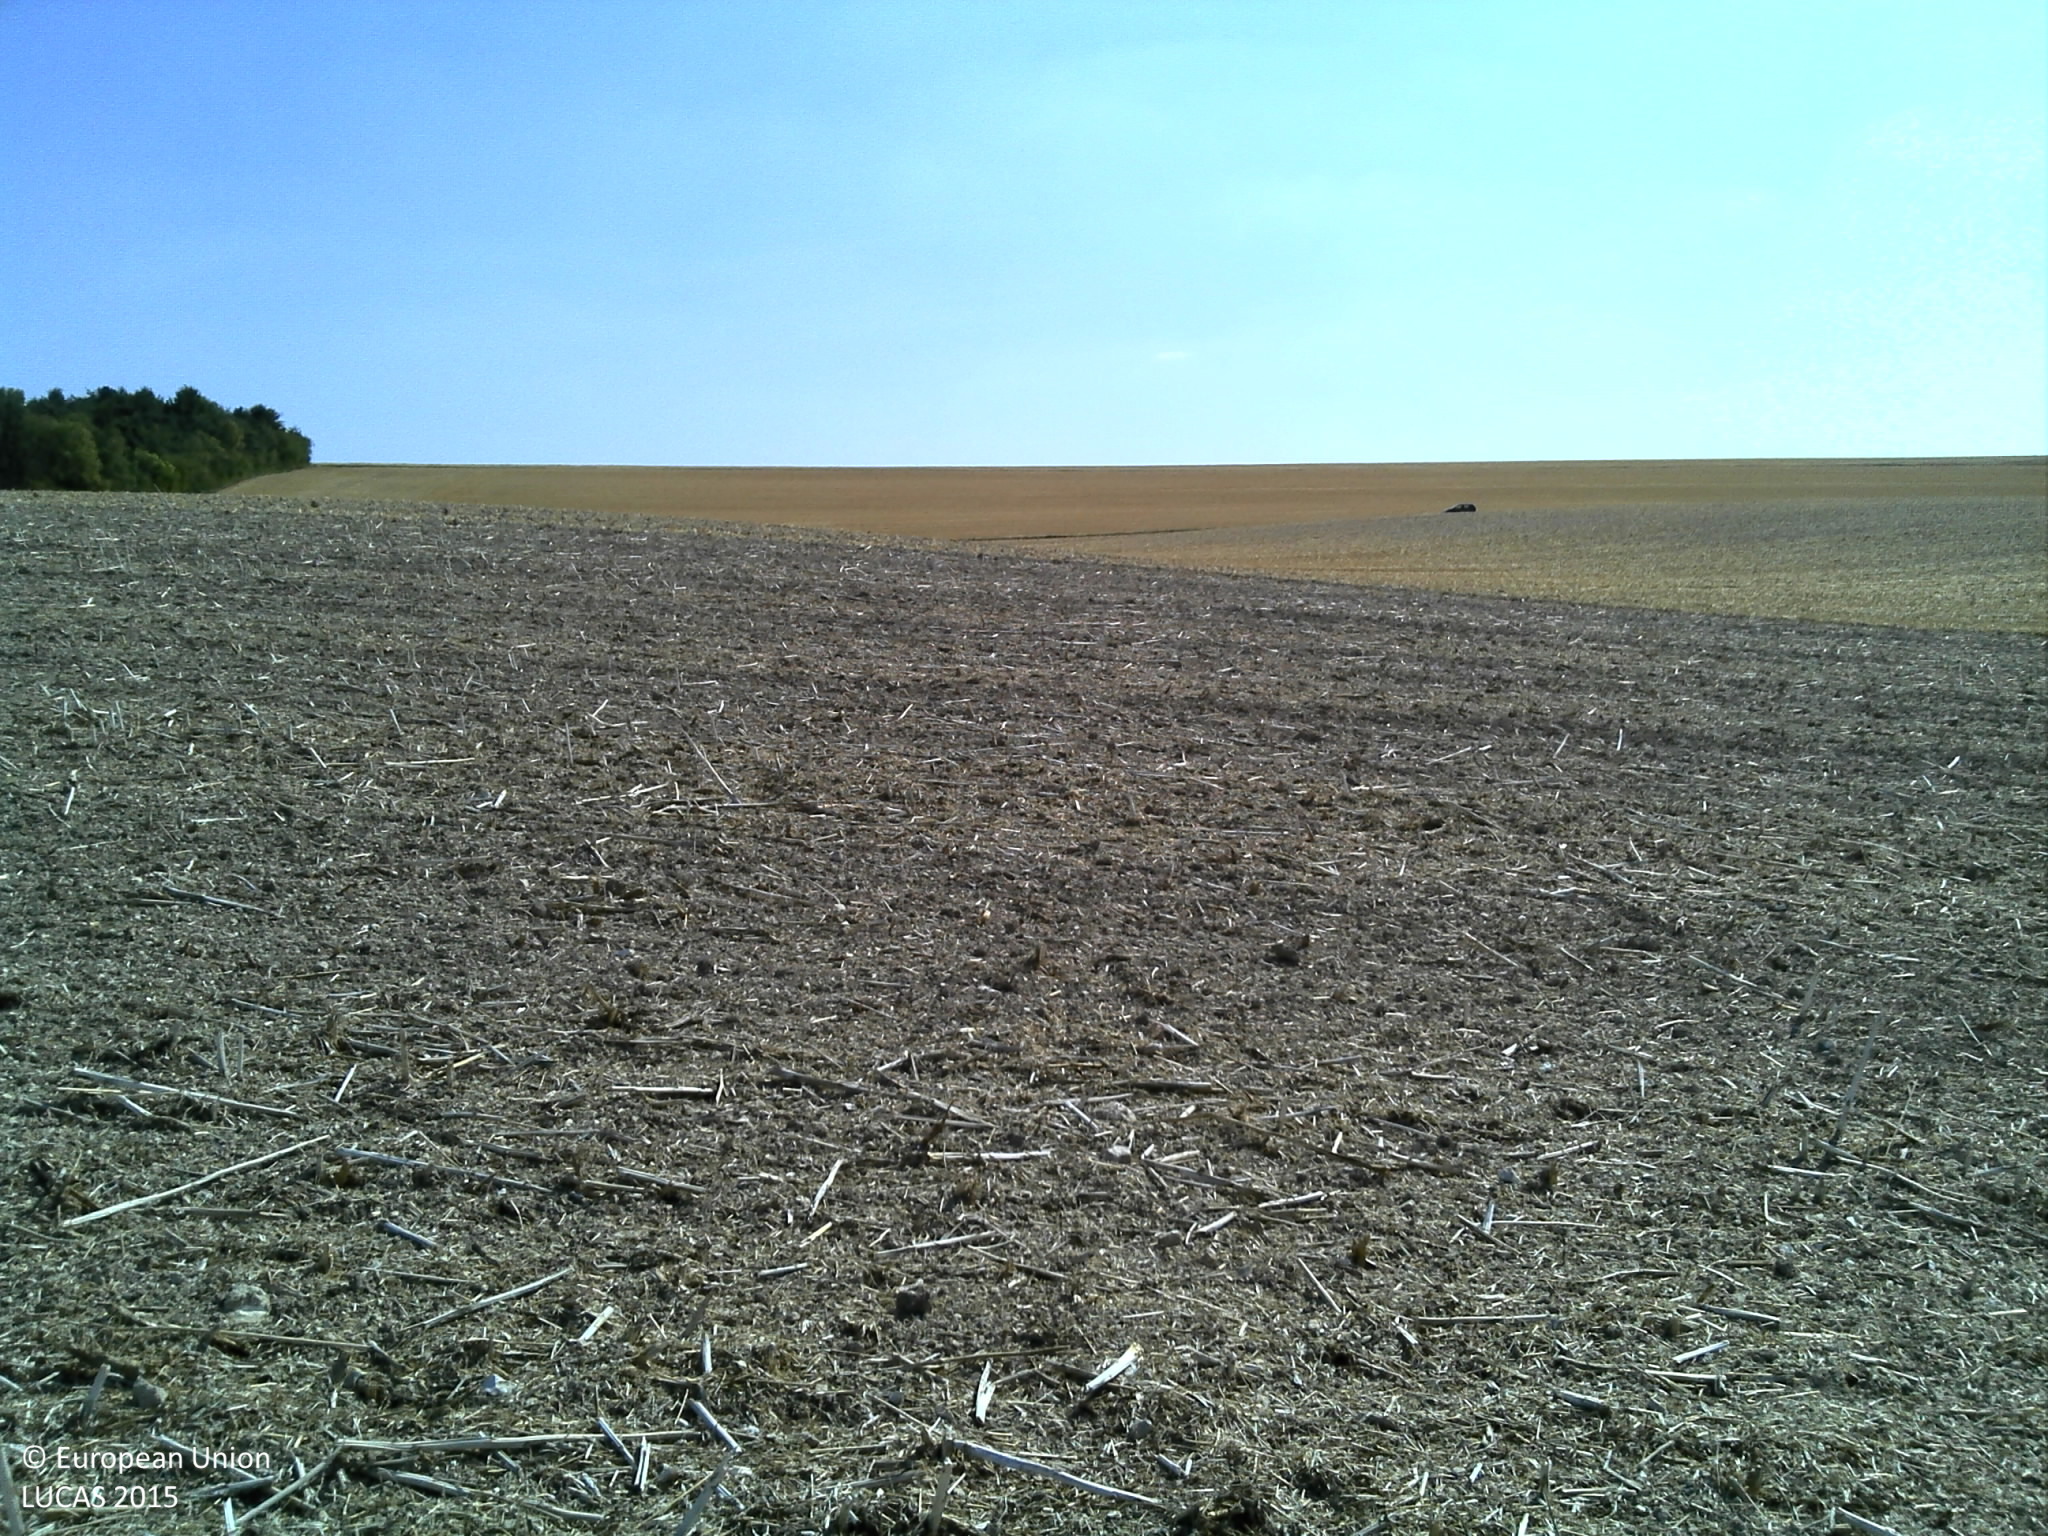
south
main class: Cropland
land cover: Rape and turnip rape
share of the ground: > 75 %
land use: Agriculture (excluding fallow land and kitchen gardens)
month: August
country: FR
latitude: 48.9429
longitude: 4.6861
